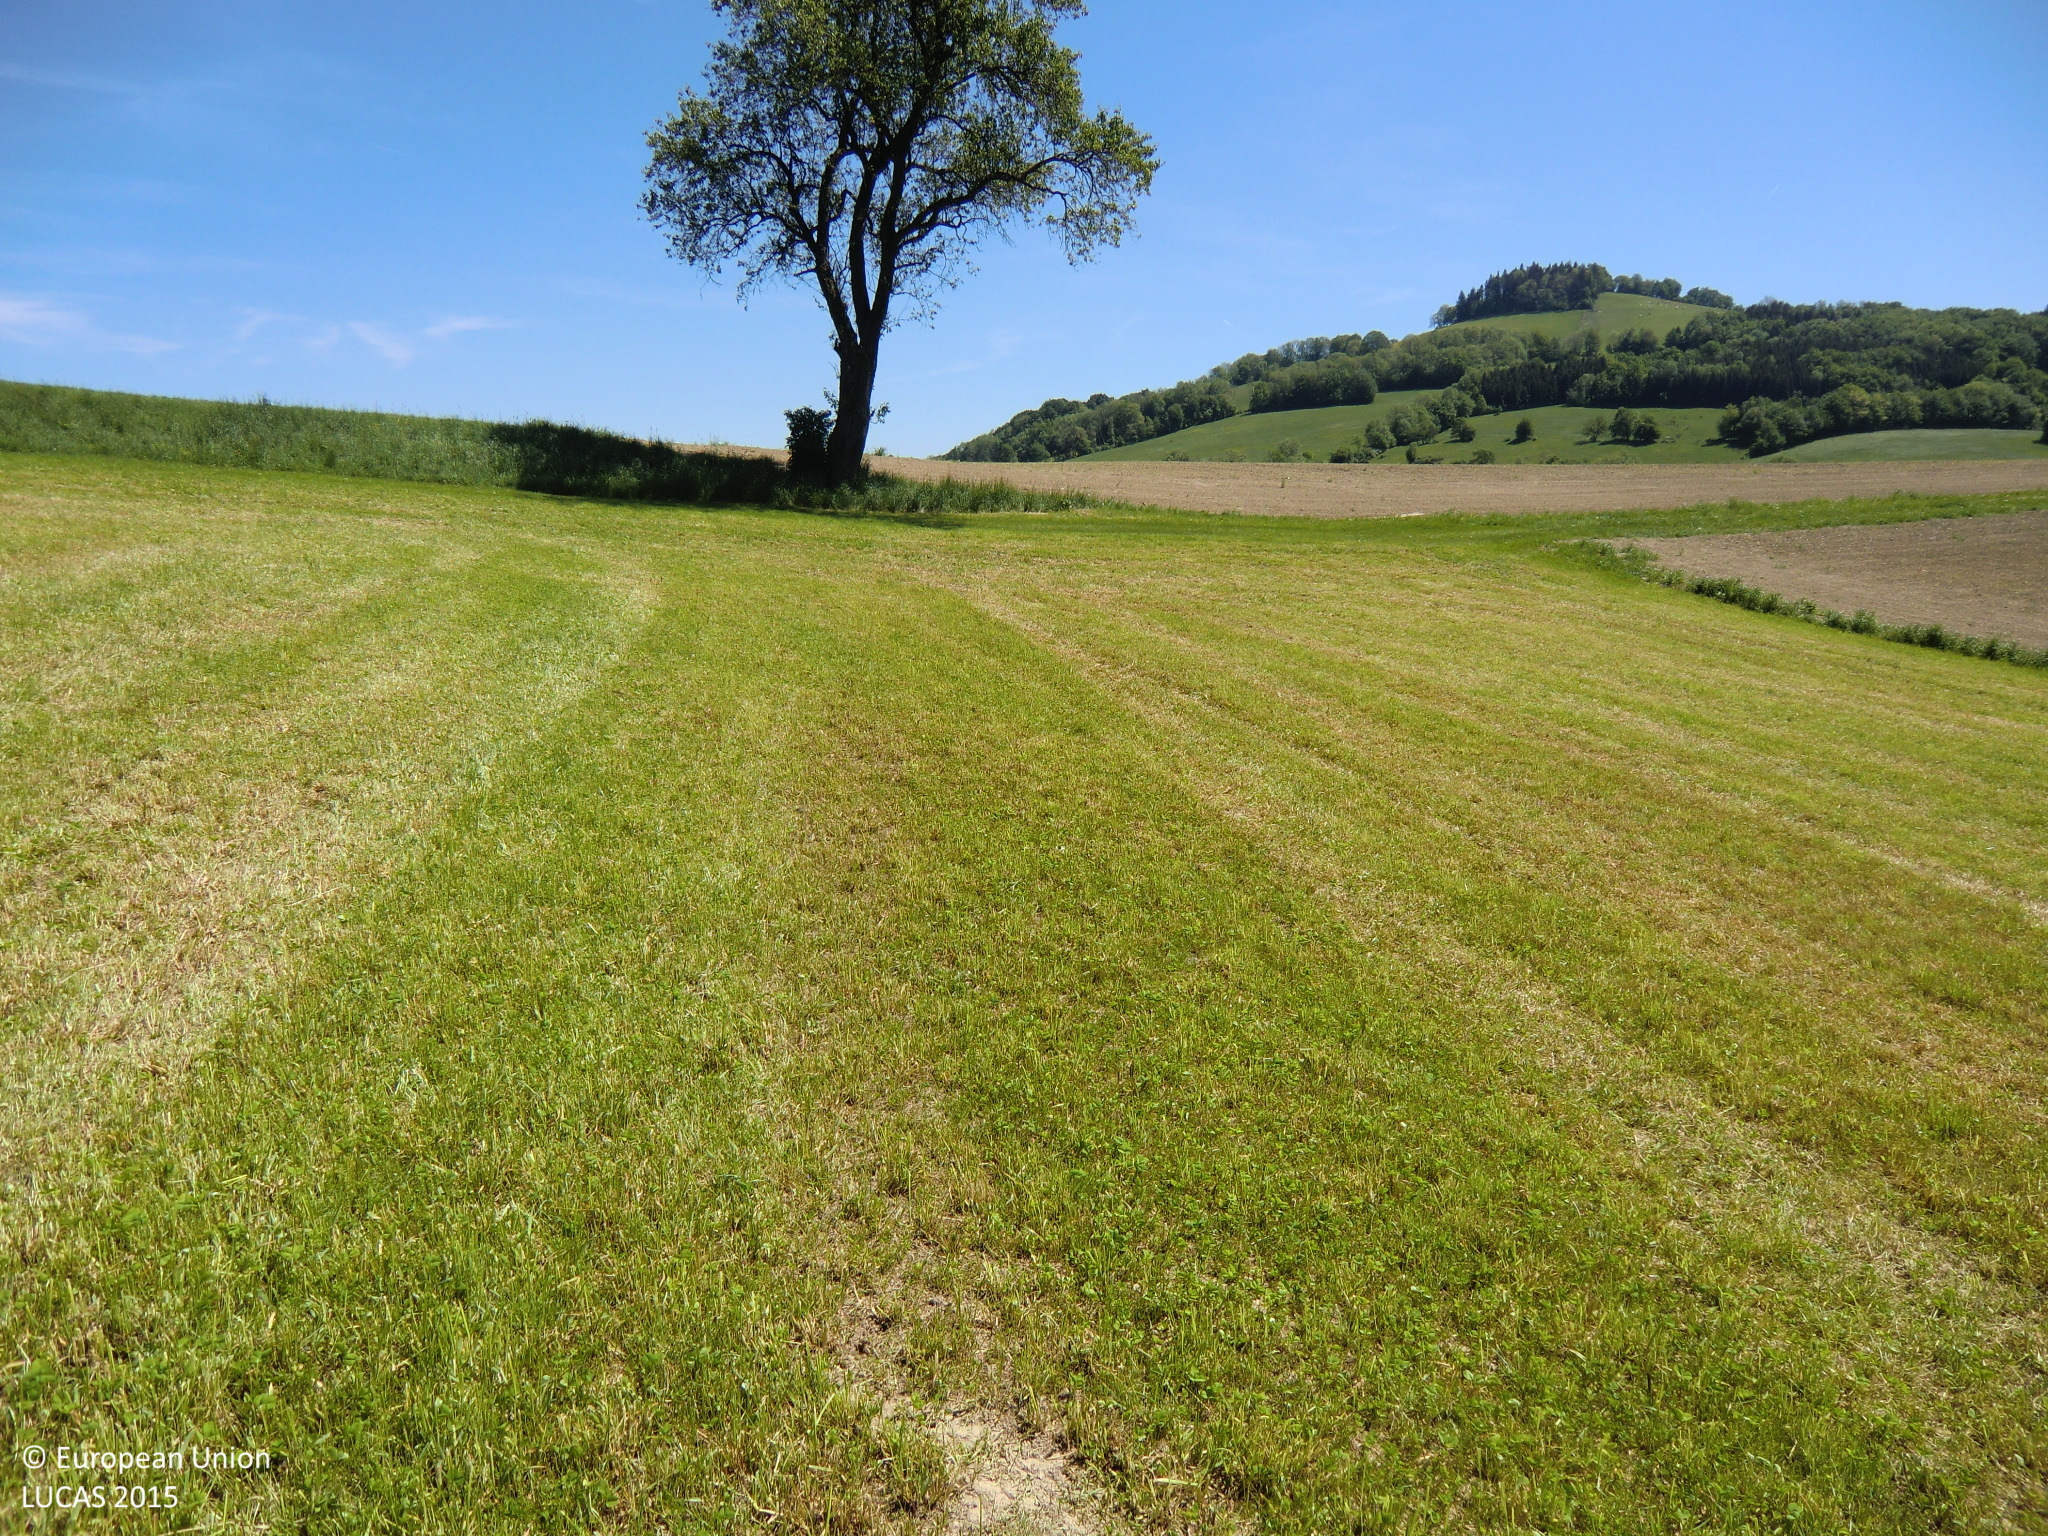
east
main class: Grassland
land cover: Grassland without tree/shrub cover
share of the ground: > 75 %
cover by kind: herbaceous plants 100 %
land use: Agriculture (excluding fallow land and kitchen gardens)
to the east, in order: Grassland without tree/shrub cover; Single bushes/trees; Maize; Tracks; Grassland without tree/shrub cover
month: May
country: AT
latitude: 48.0766
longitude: 15.3304
